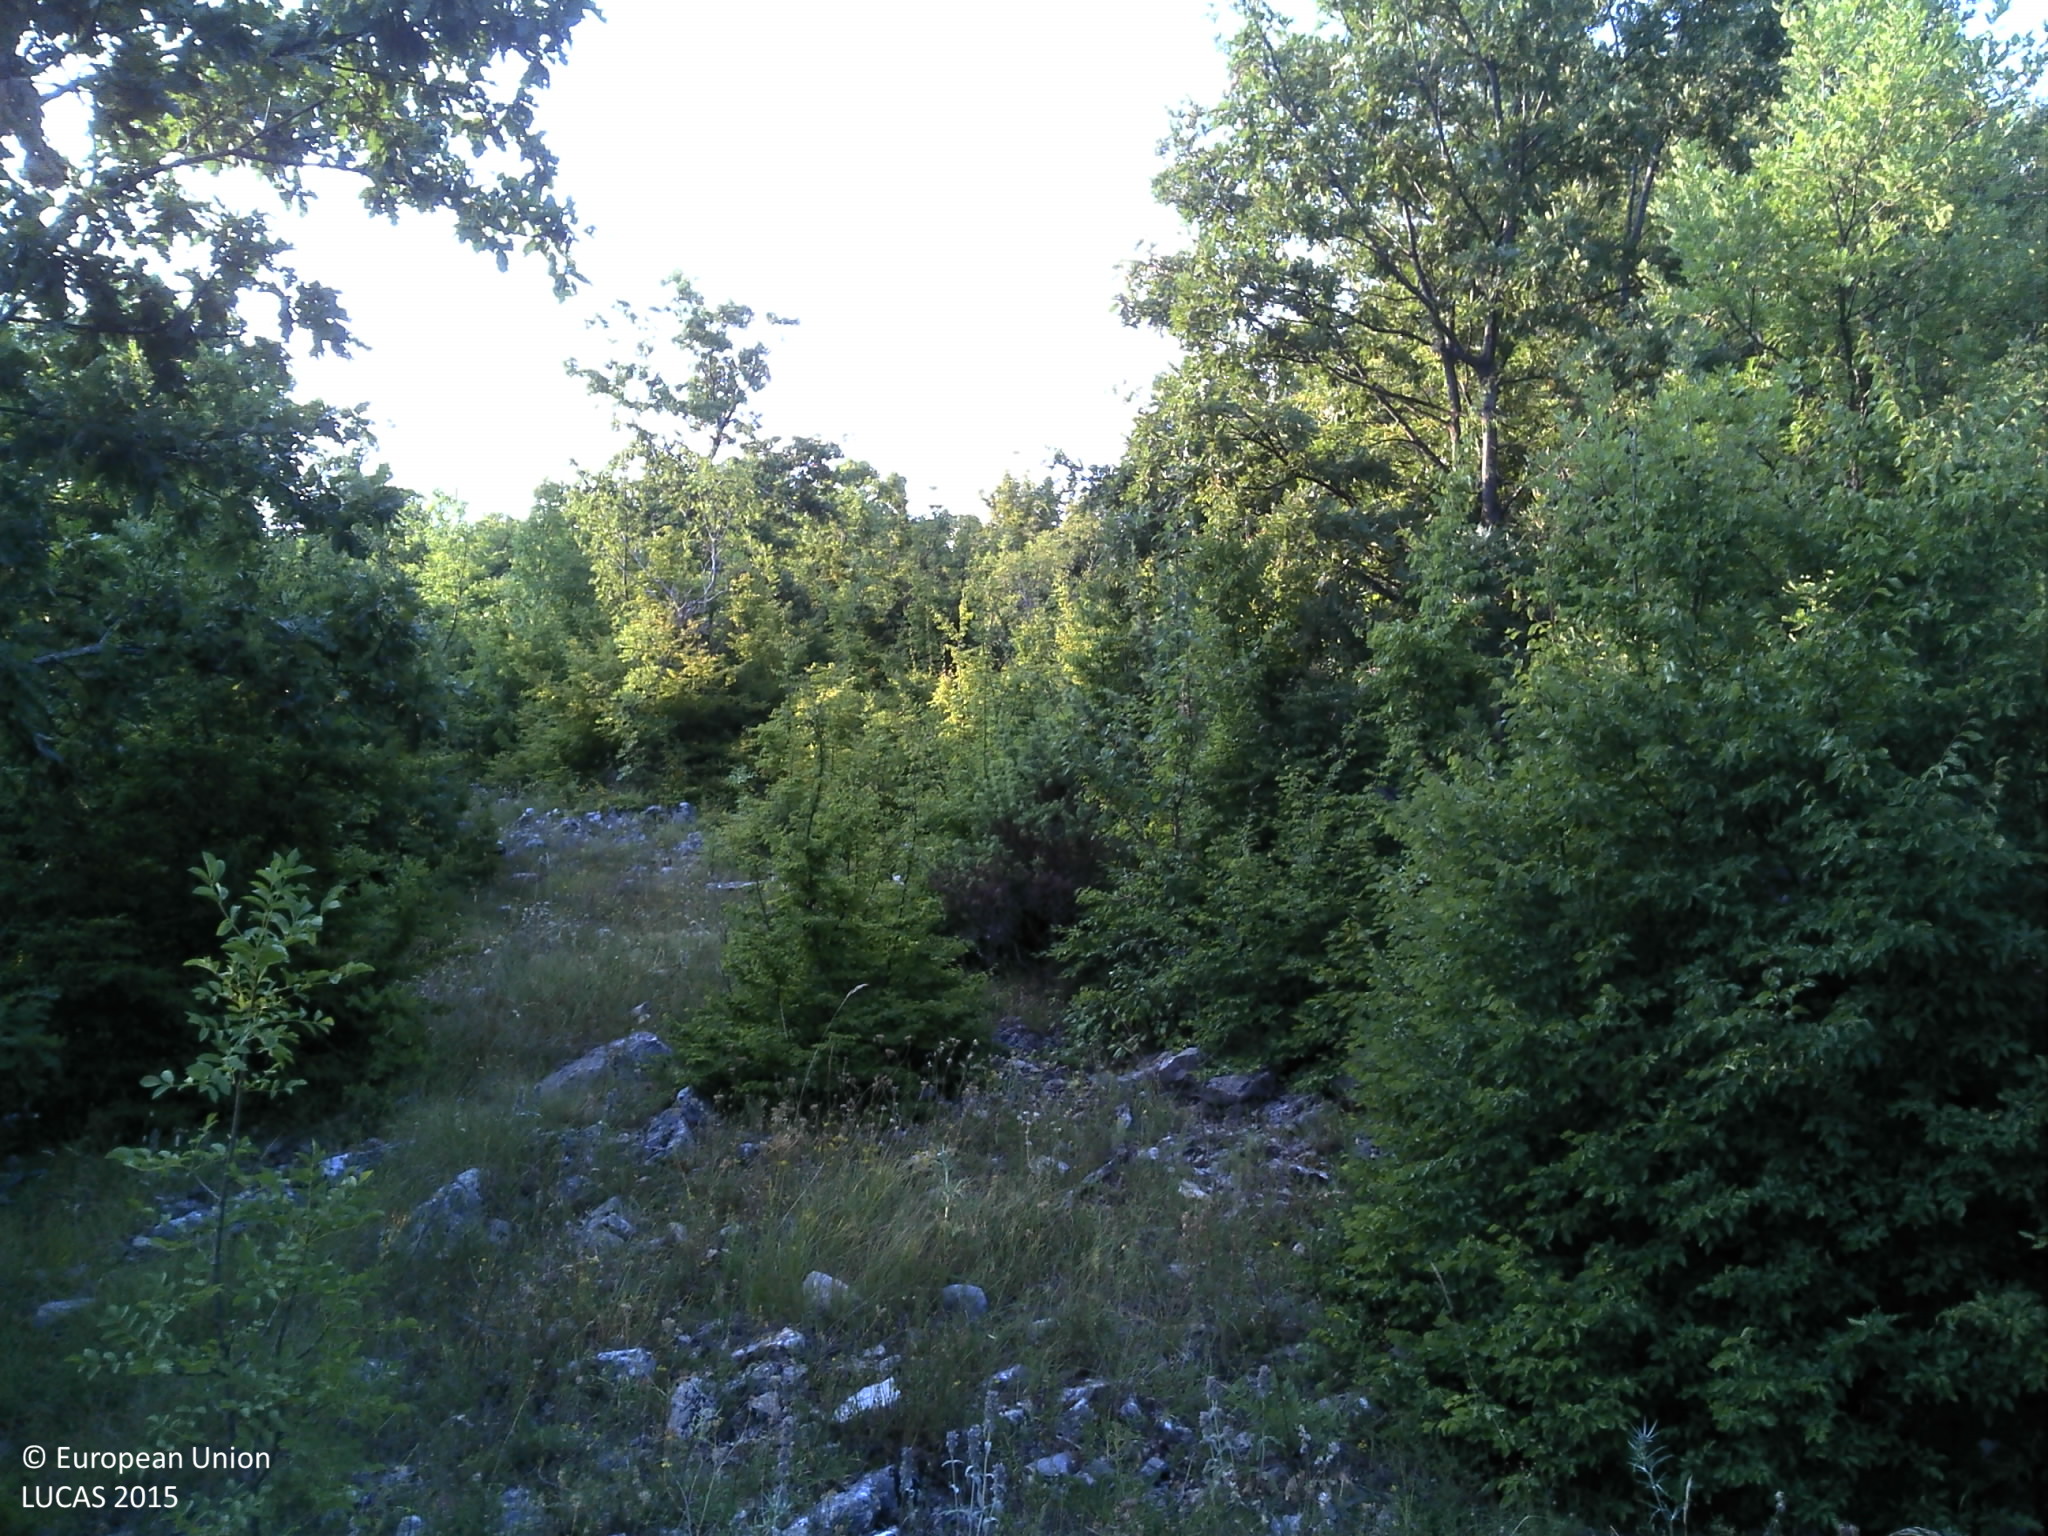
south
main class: Woodland
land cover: Broadleaved woodland
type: thermophilous deciduous forest
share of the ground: 50 - 75 %
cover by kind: broadleaved forest trees 50 %, shrubs 40 %, unconsolidated bare surface 10 %
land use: Semi-natural and natural areas not in use
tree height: > 5 m
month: July
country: HR
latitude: 44.0134
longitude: 16.3167
